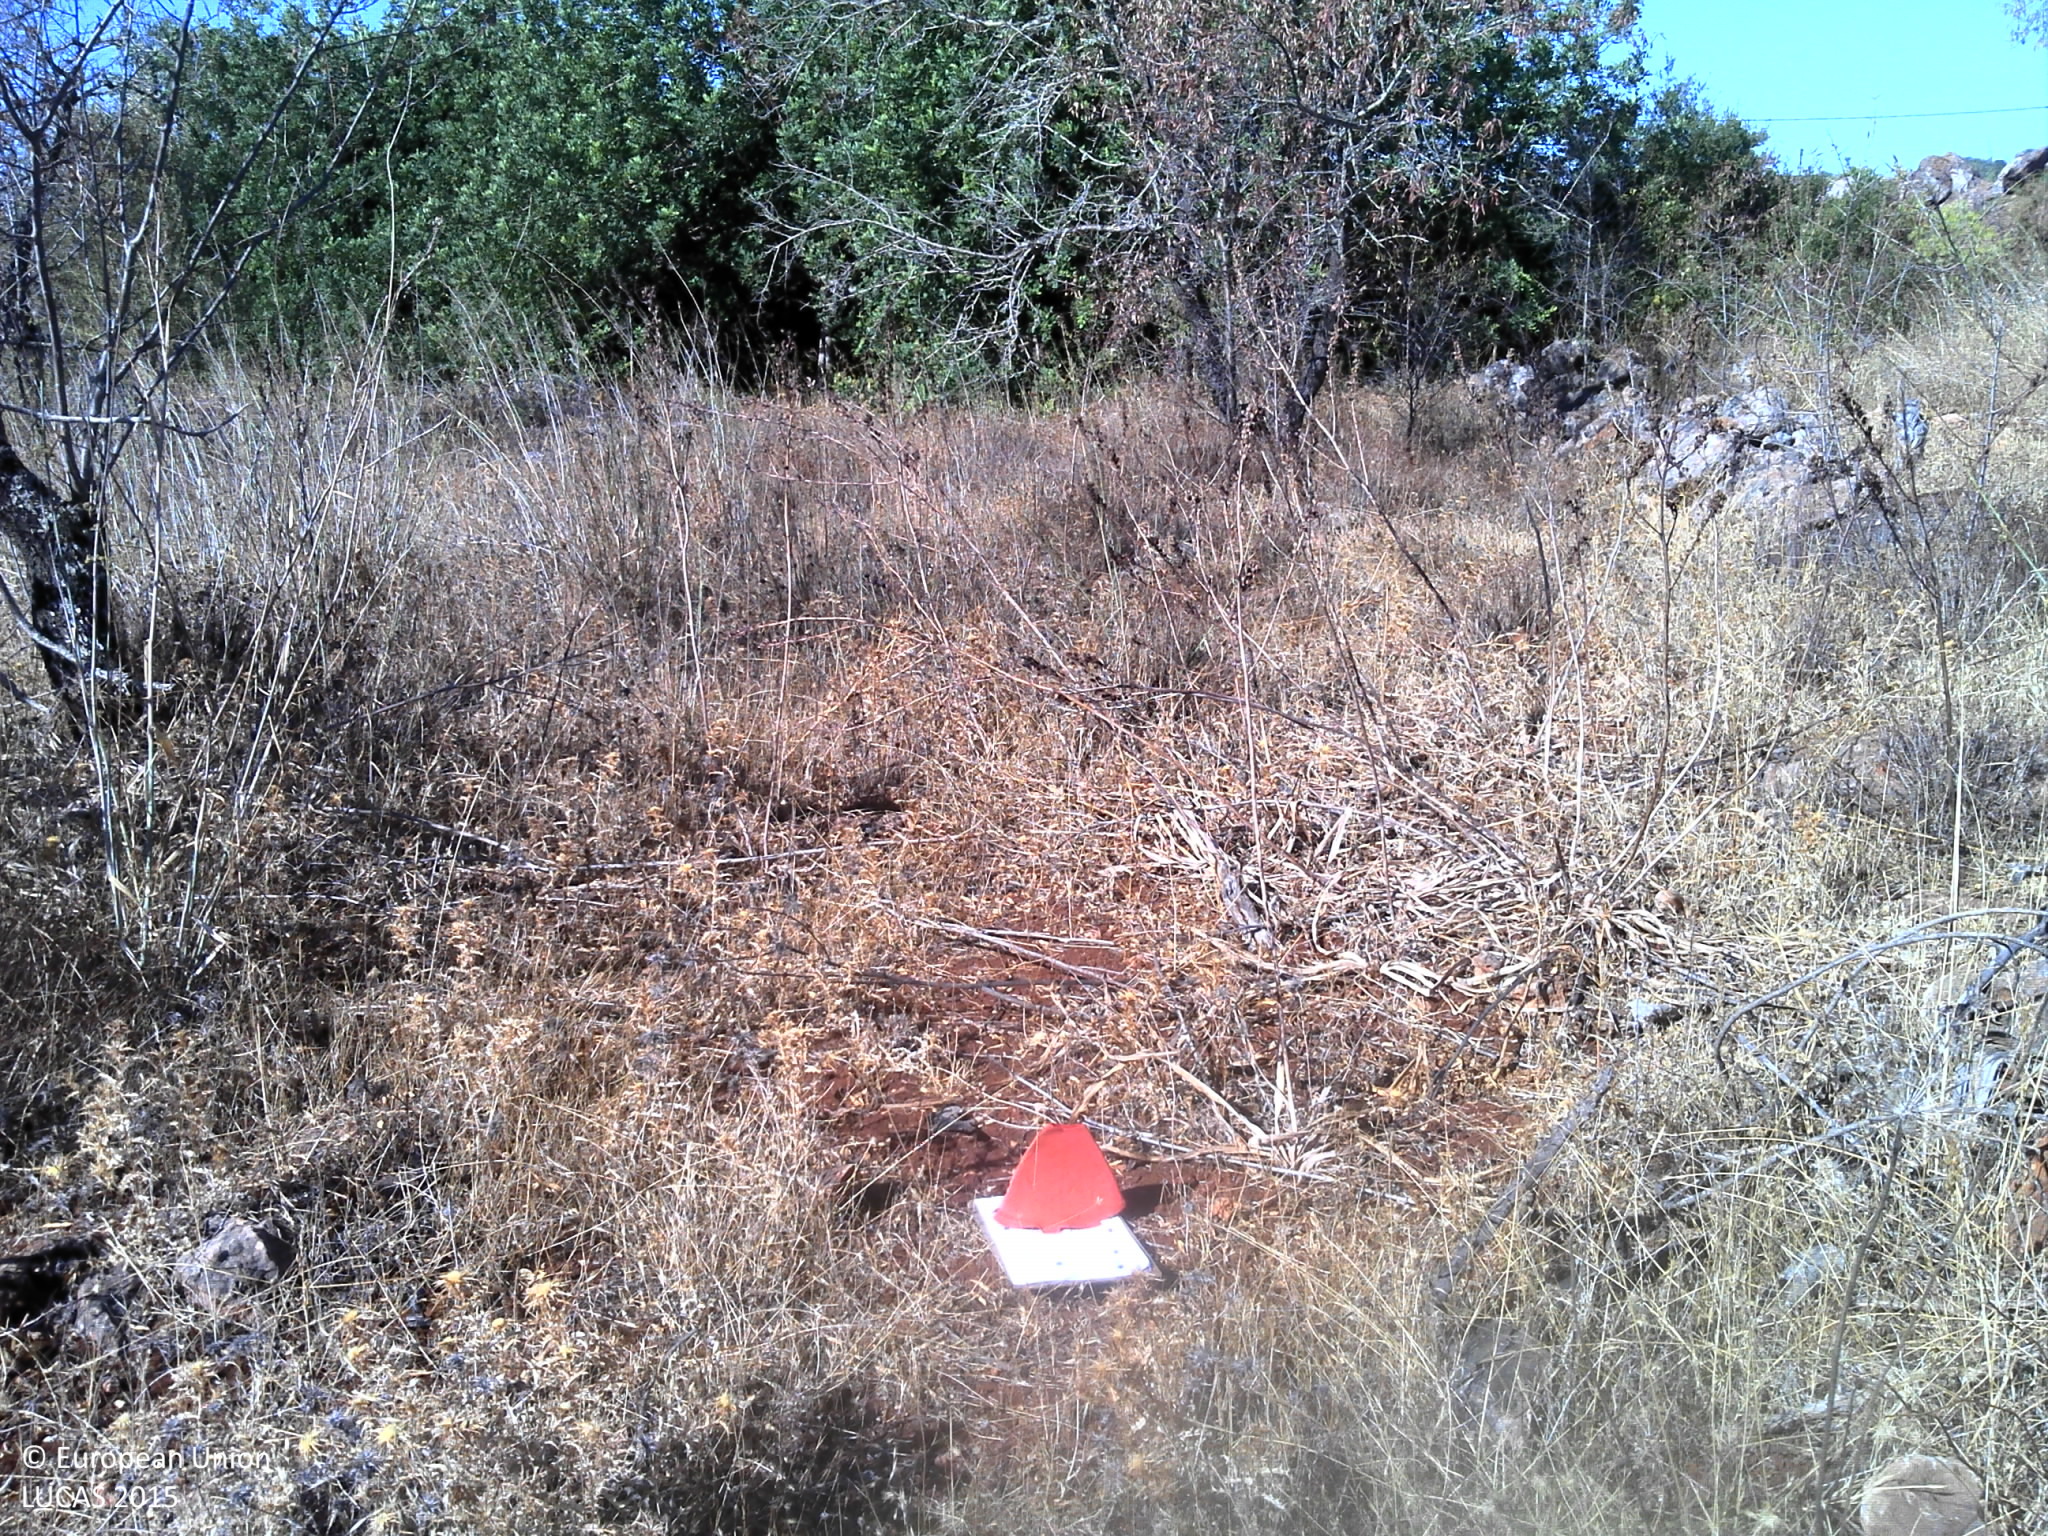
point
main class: Cropland
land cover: Nuts trees
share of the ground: 25 - 50 %
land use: Agriculture (excluding fallow land and kitchen gardens)
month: September
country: PT
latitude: 37.2347
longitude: -8.2008
